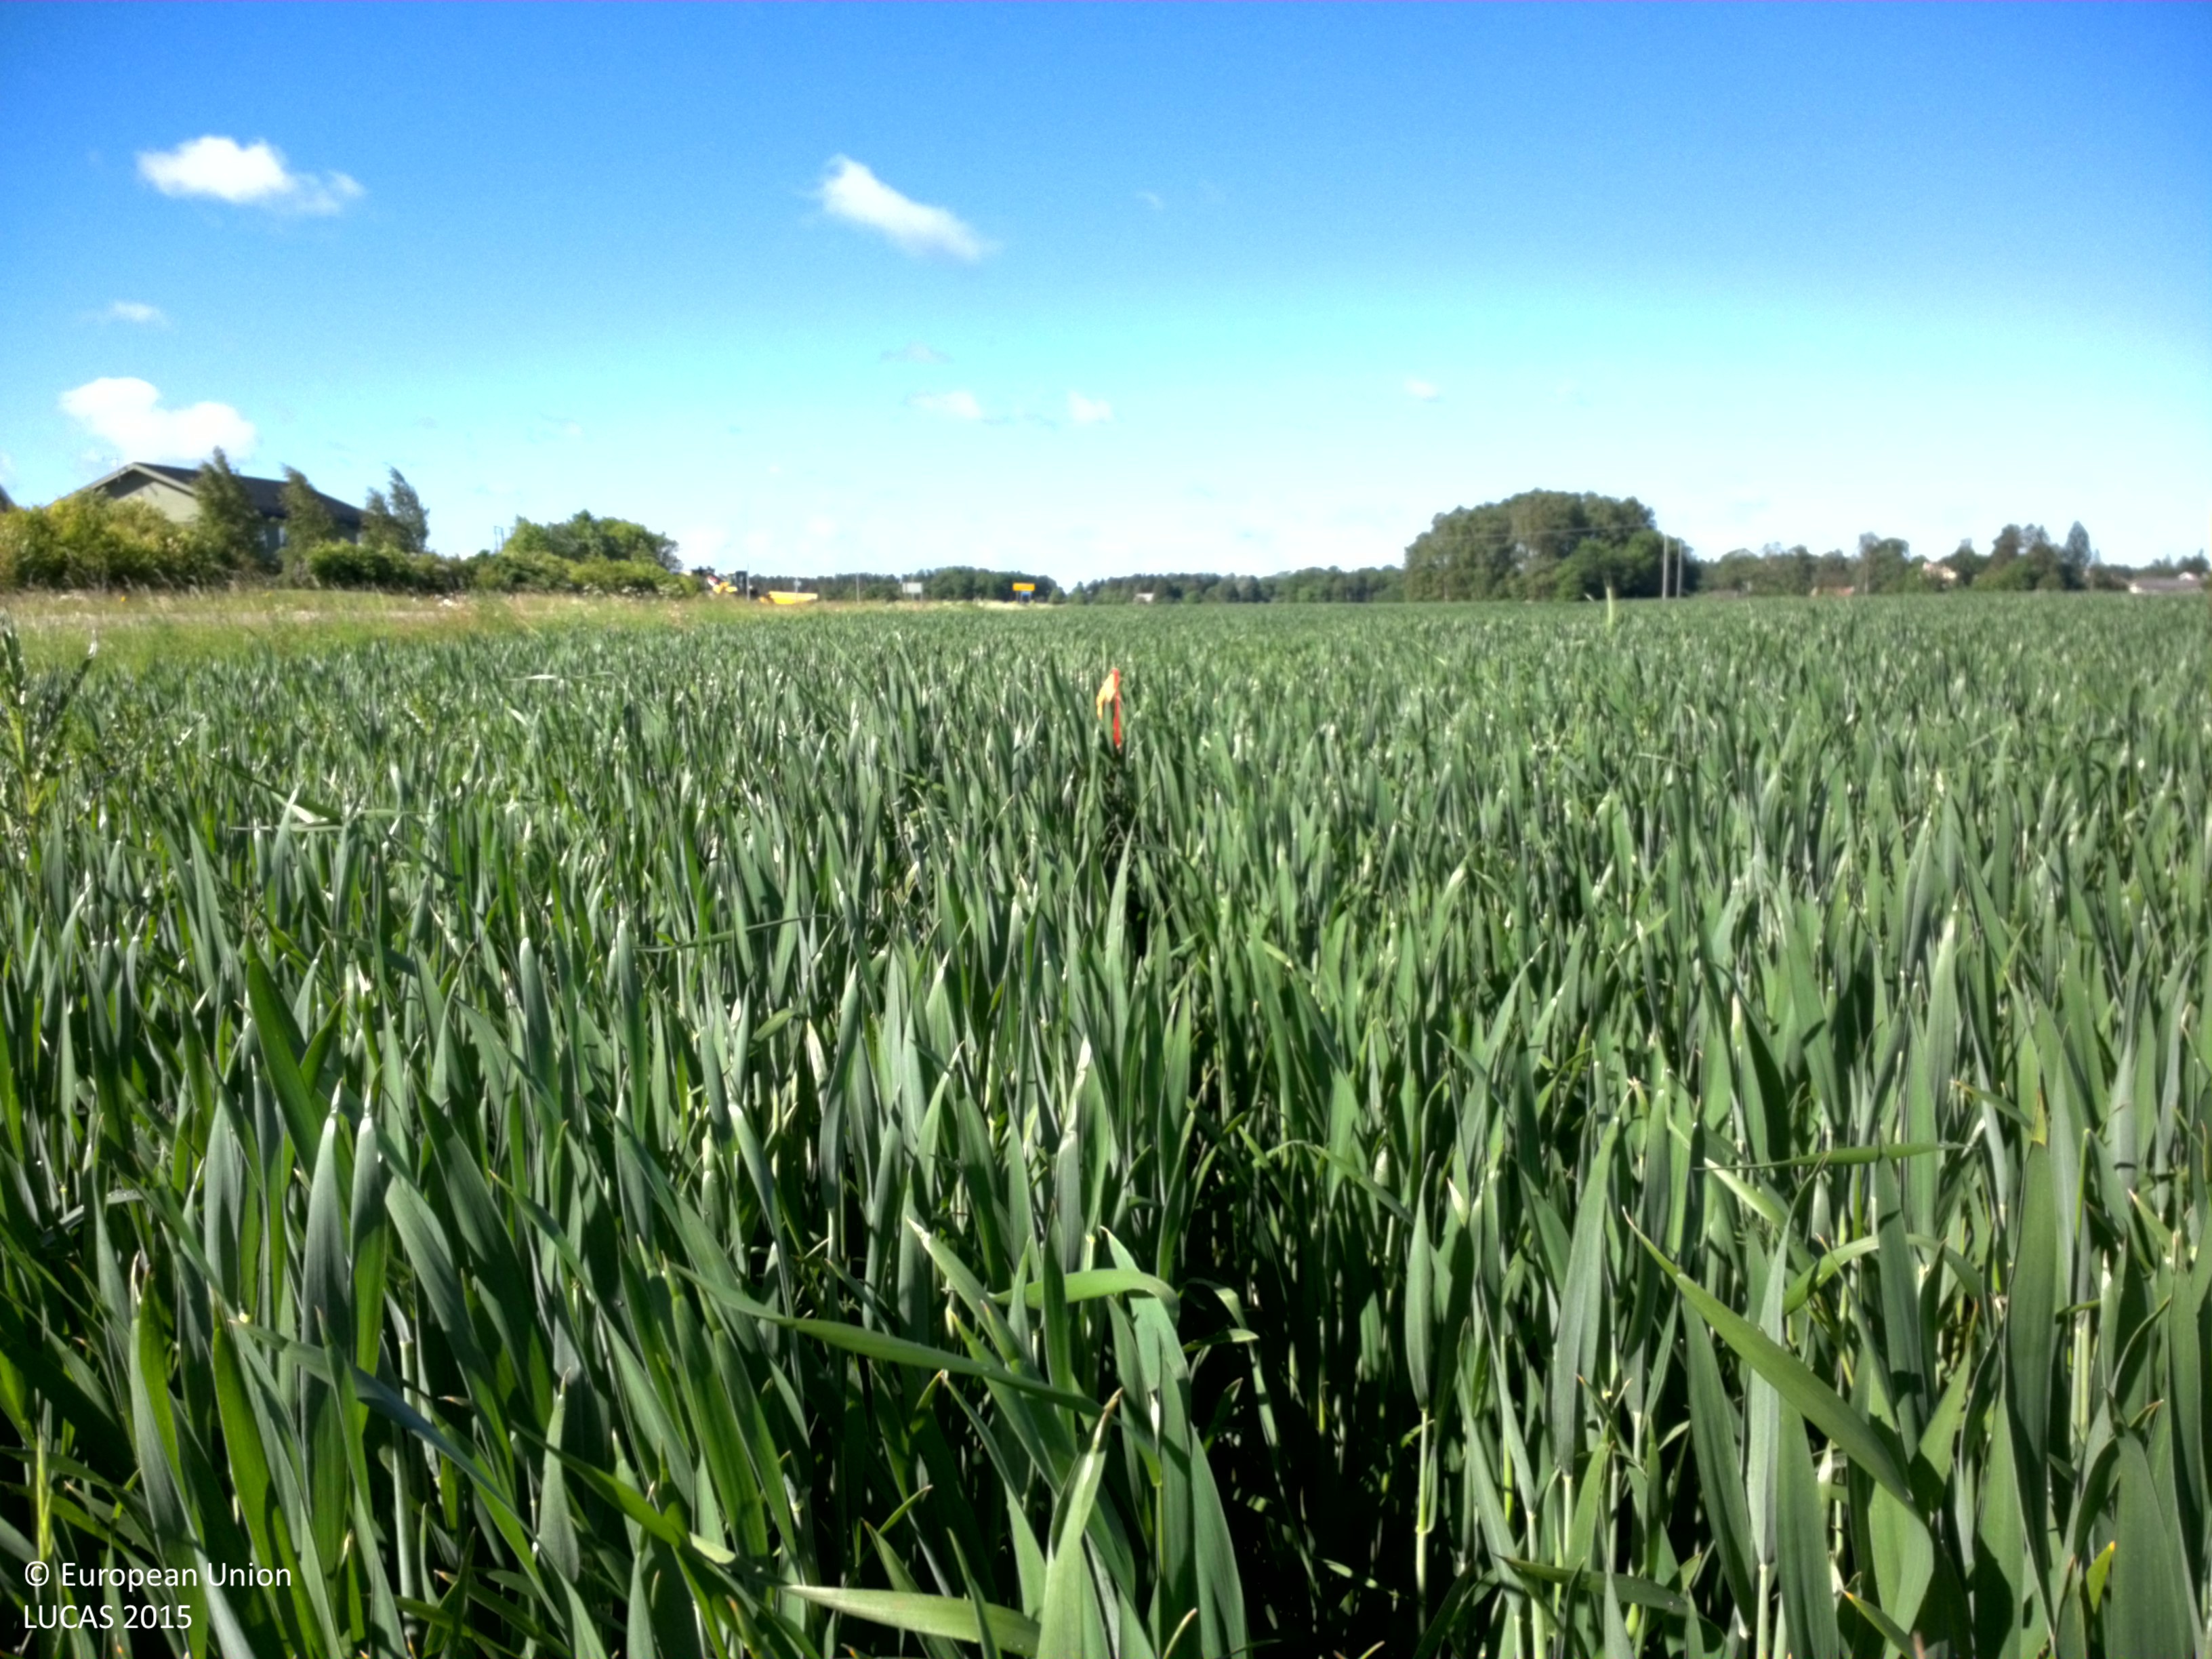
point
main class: Cropland
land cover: Common wheat
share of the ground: > 75 %
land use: Agriculture (excluding fallow land and kitchen gardens)
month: June
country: SE
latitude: 59.9592
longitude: 17.5688
